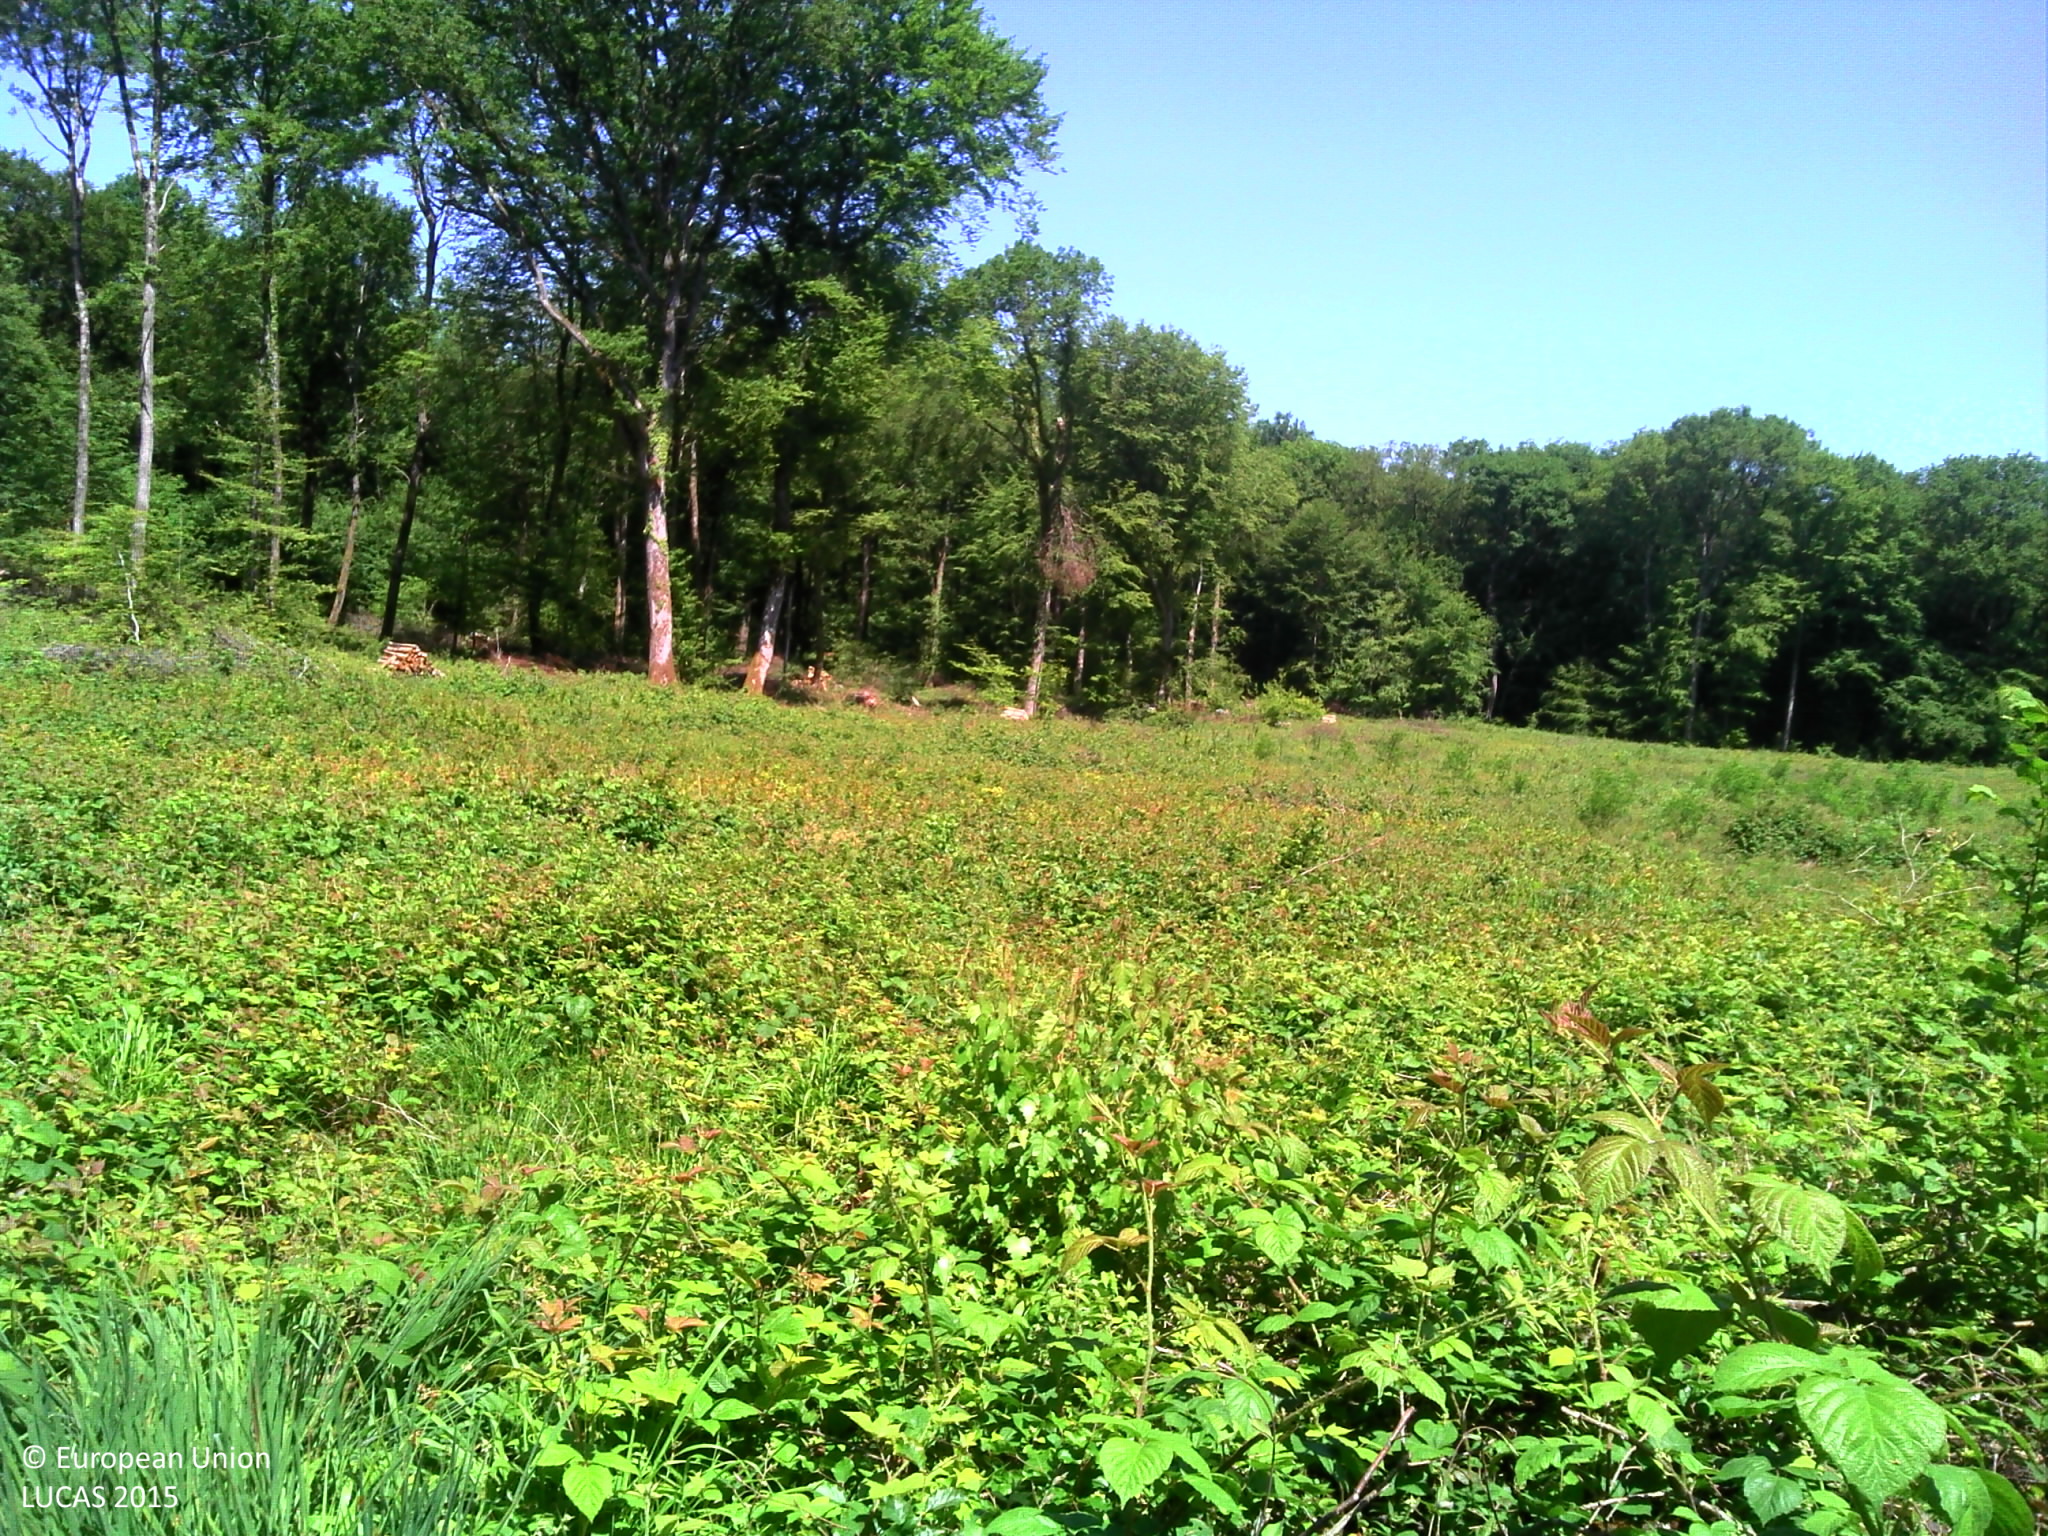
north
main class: Woodland
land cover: Broadleaved woodland
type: mesophytic deciduous forest
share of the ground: > 75 %
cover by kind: broadleaved forest trees 55 %, shrubs 20 %, herbaceous plants 15 %, coniferous forest trees 5 %, unconsolidated bare surface 5 %
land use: Forestry
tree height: < 5 m
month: June
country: FR
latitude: 47.5933
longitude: 6.0249
